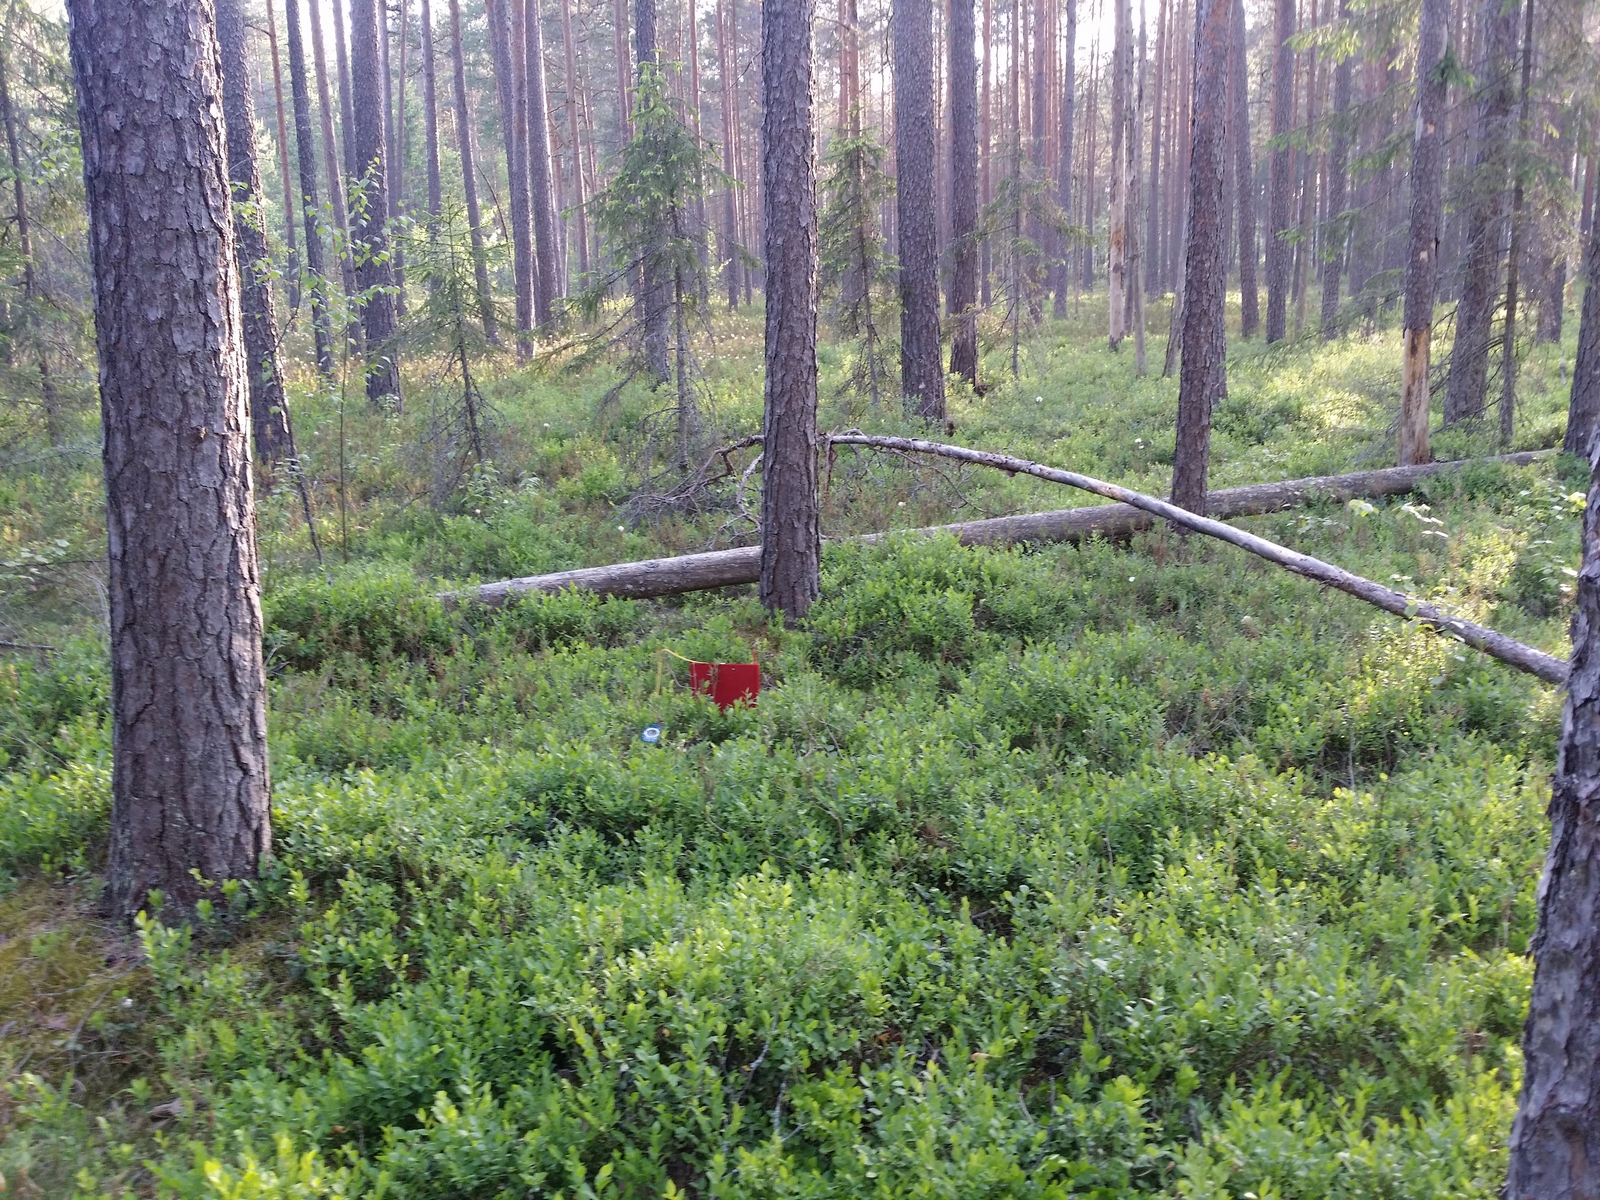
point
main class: Woodland
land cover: Other coniferous woodland
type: hemiboreal forest and nemoral coniferous forest and mixed broadleaved-coniferous forest
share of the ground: > 75 %
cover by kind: coniferous forest trees 80 %, lichens and mosses 20 %
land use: Forestry
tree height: > 5 m
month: June
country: LV
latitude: 57.2787
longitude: 26.5156
